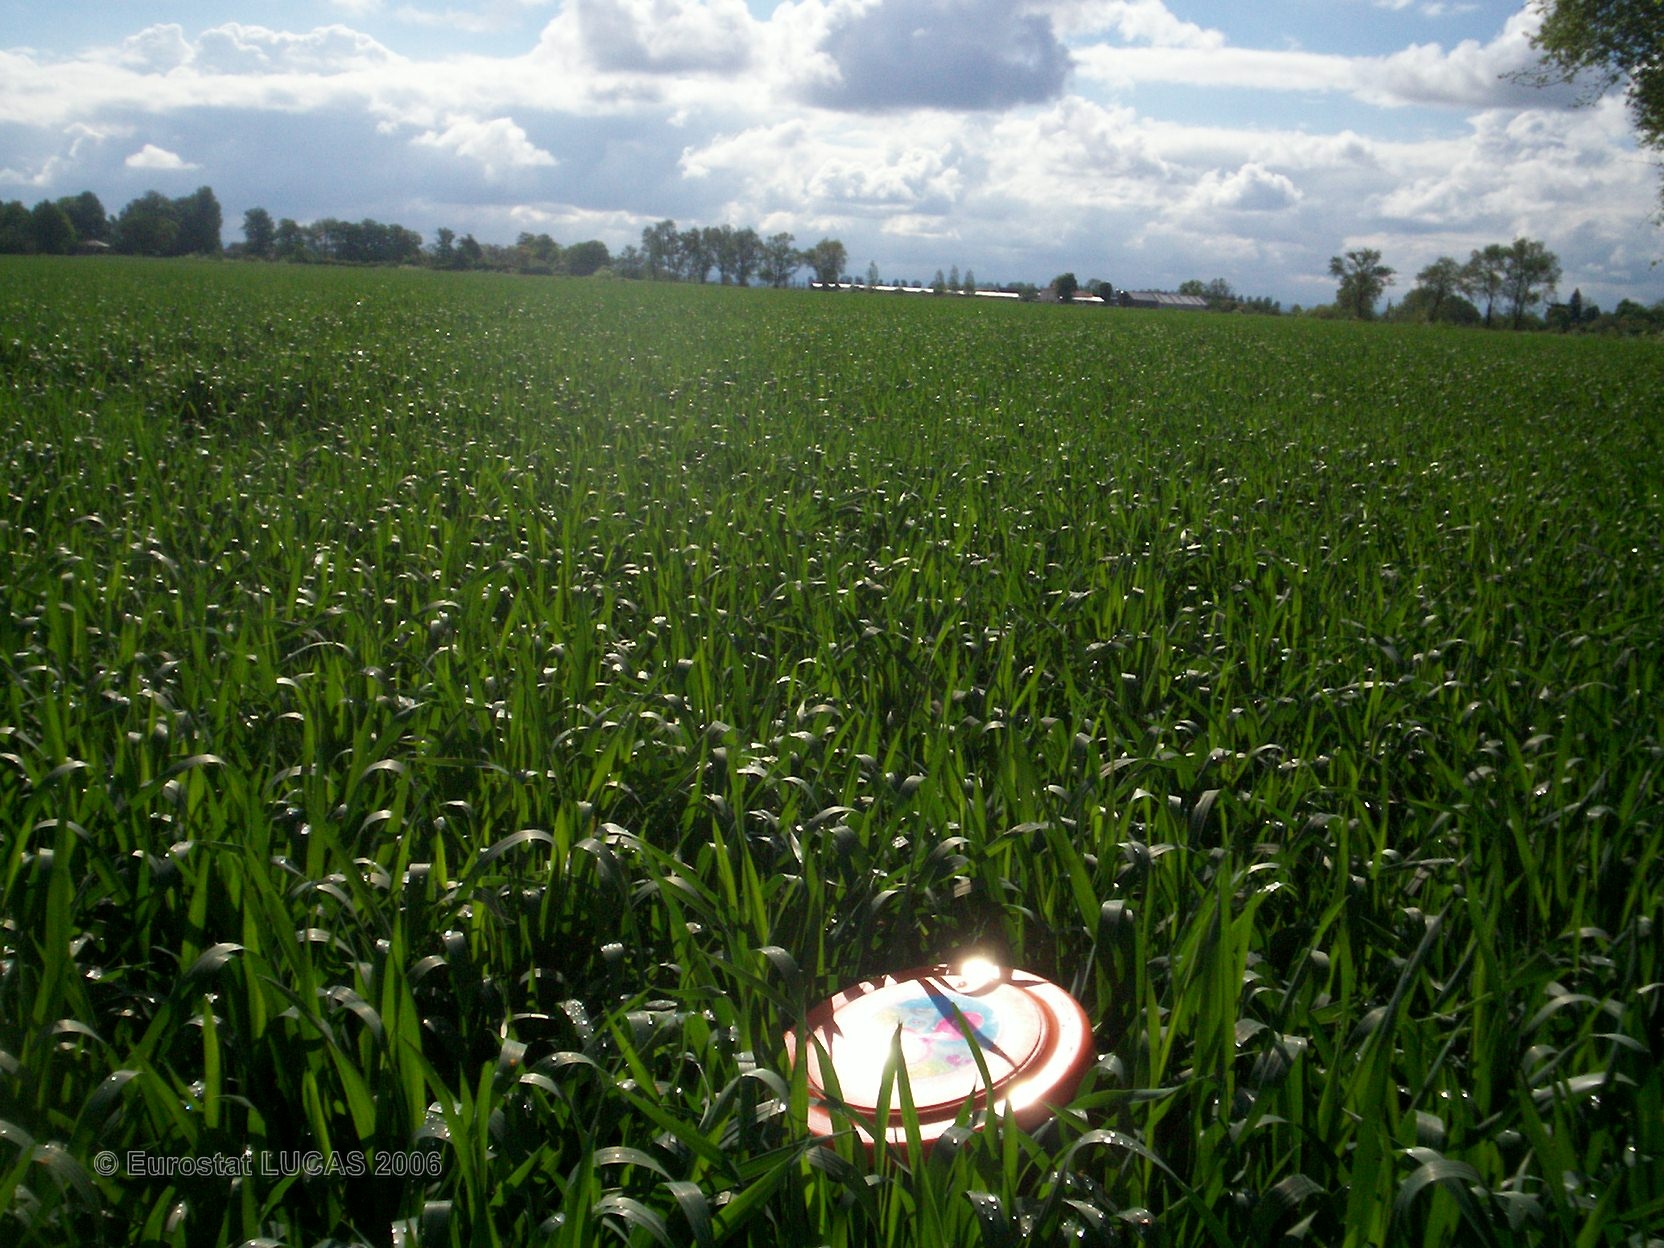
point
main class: Cropland
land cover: Common wheat
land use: Agriculture (excluding fallow land and kitchen gardens)
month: May
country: FR
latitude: 45.8986
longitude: 3.1814
